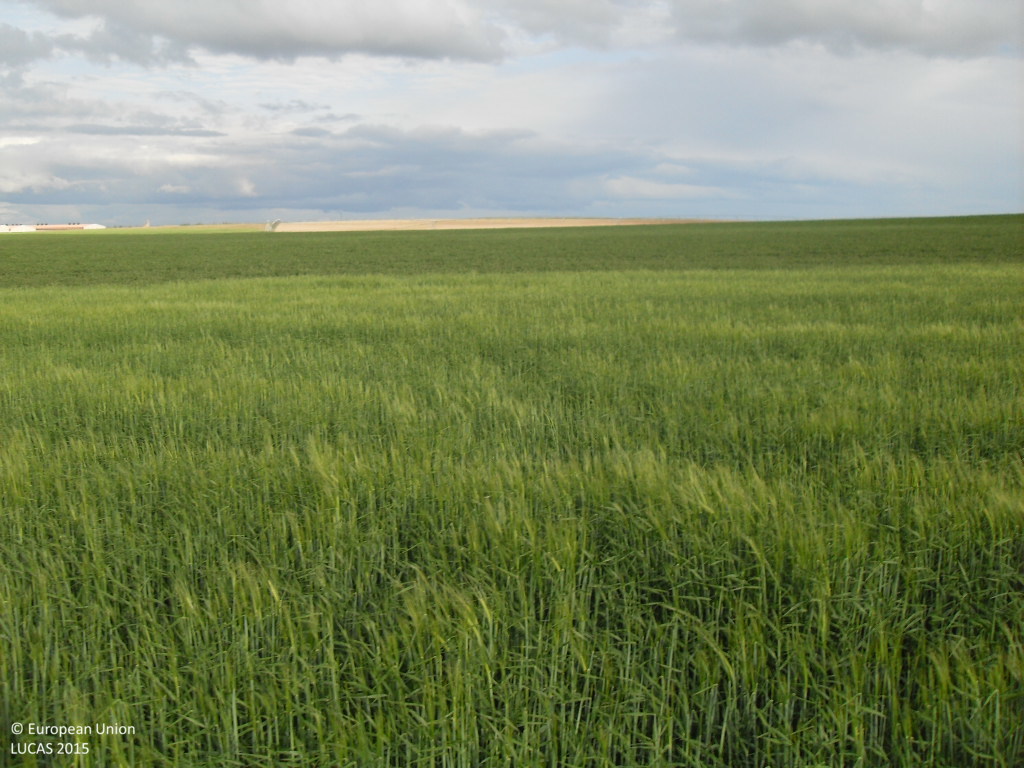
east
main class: Cropland
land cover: Barley
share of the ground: > 75 %
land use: Agriculture (excluding fallow land and kitchen gardens)
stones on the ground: < 10 %
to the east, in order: Barley; Lucerne
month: April
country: ES
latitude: 41.0067
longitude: -5.1805
